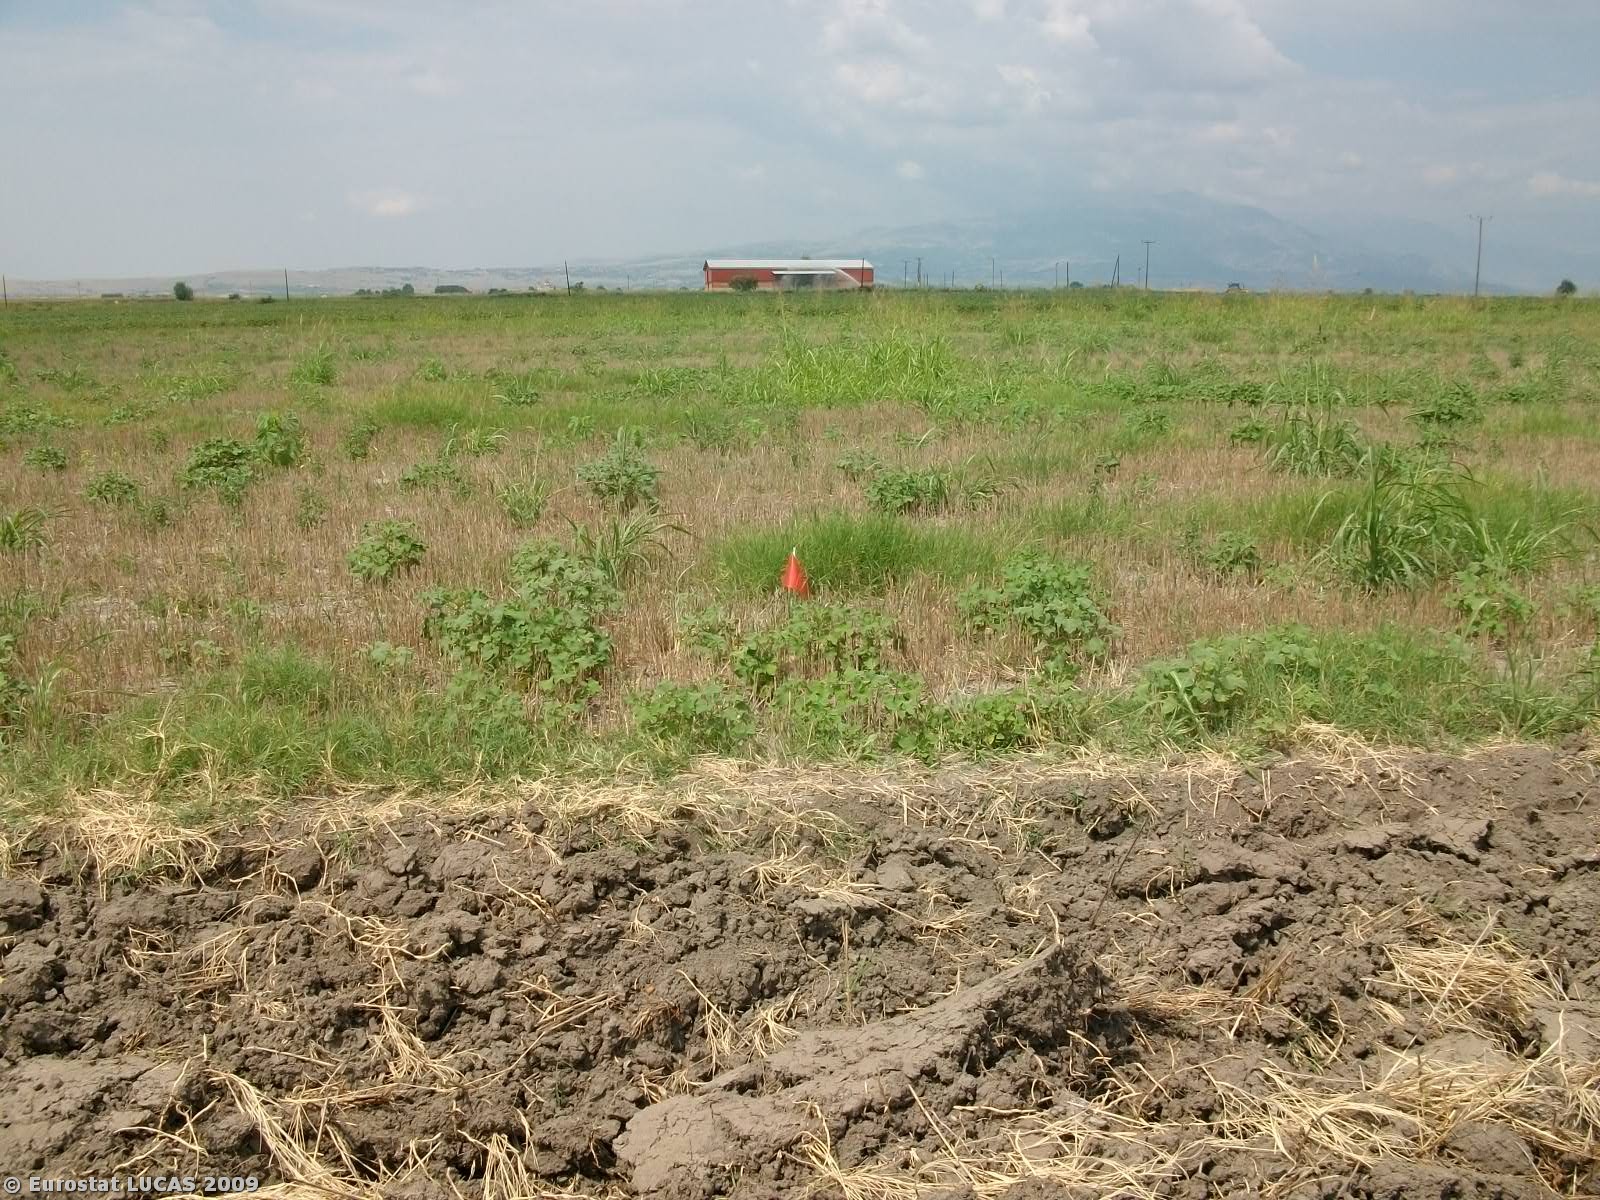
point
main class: Cropland
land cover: Durum wheat
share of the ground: < 10 %
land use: Agriculture (excluding fallow land and kitchen gardens)
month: August
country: GR
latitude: 41.0606
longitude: 24.0805
